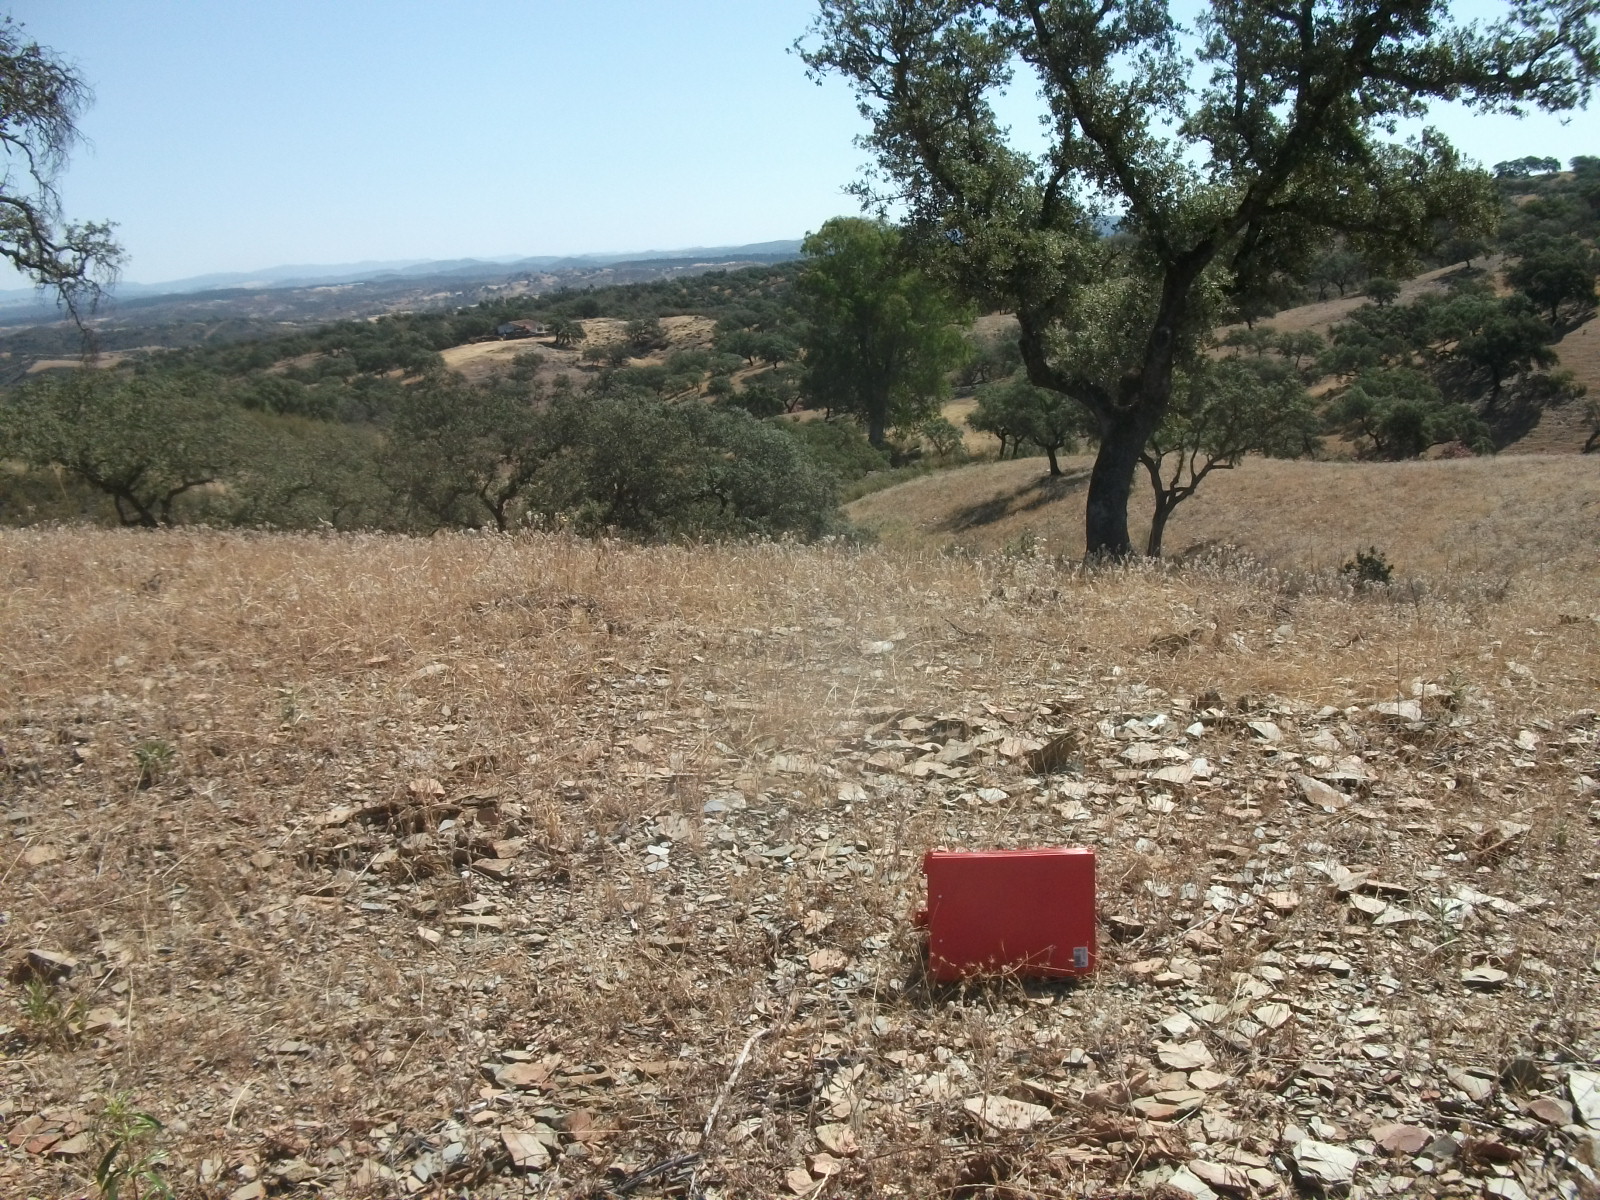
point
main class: Woodland
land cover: Broadleaved woodland
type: broadleaved evergreen forest
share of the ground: 25 - 50 %
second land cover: Grassland without tree/shrub cover
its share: > 75 %
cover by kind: herbaceous plants 70 %, broadleaved forest trees 30 %
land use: Forestry
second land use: Agriculture (excluding fallow land and kitchen gardens)
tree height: > 5 m
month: June
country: ES
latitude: 37.6039
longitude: -7.0263
